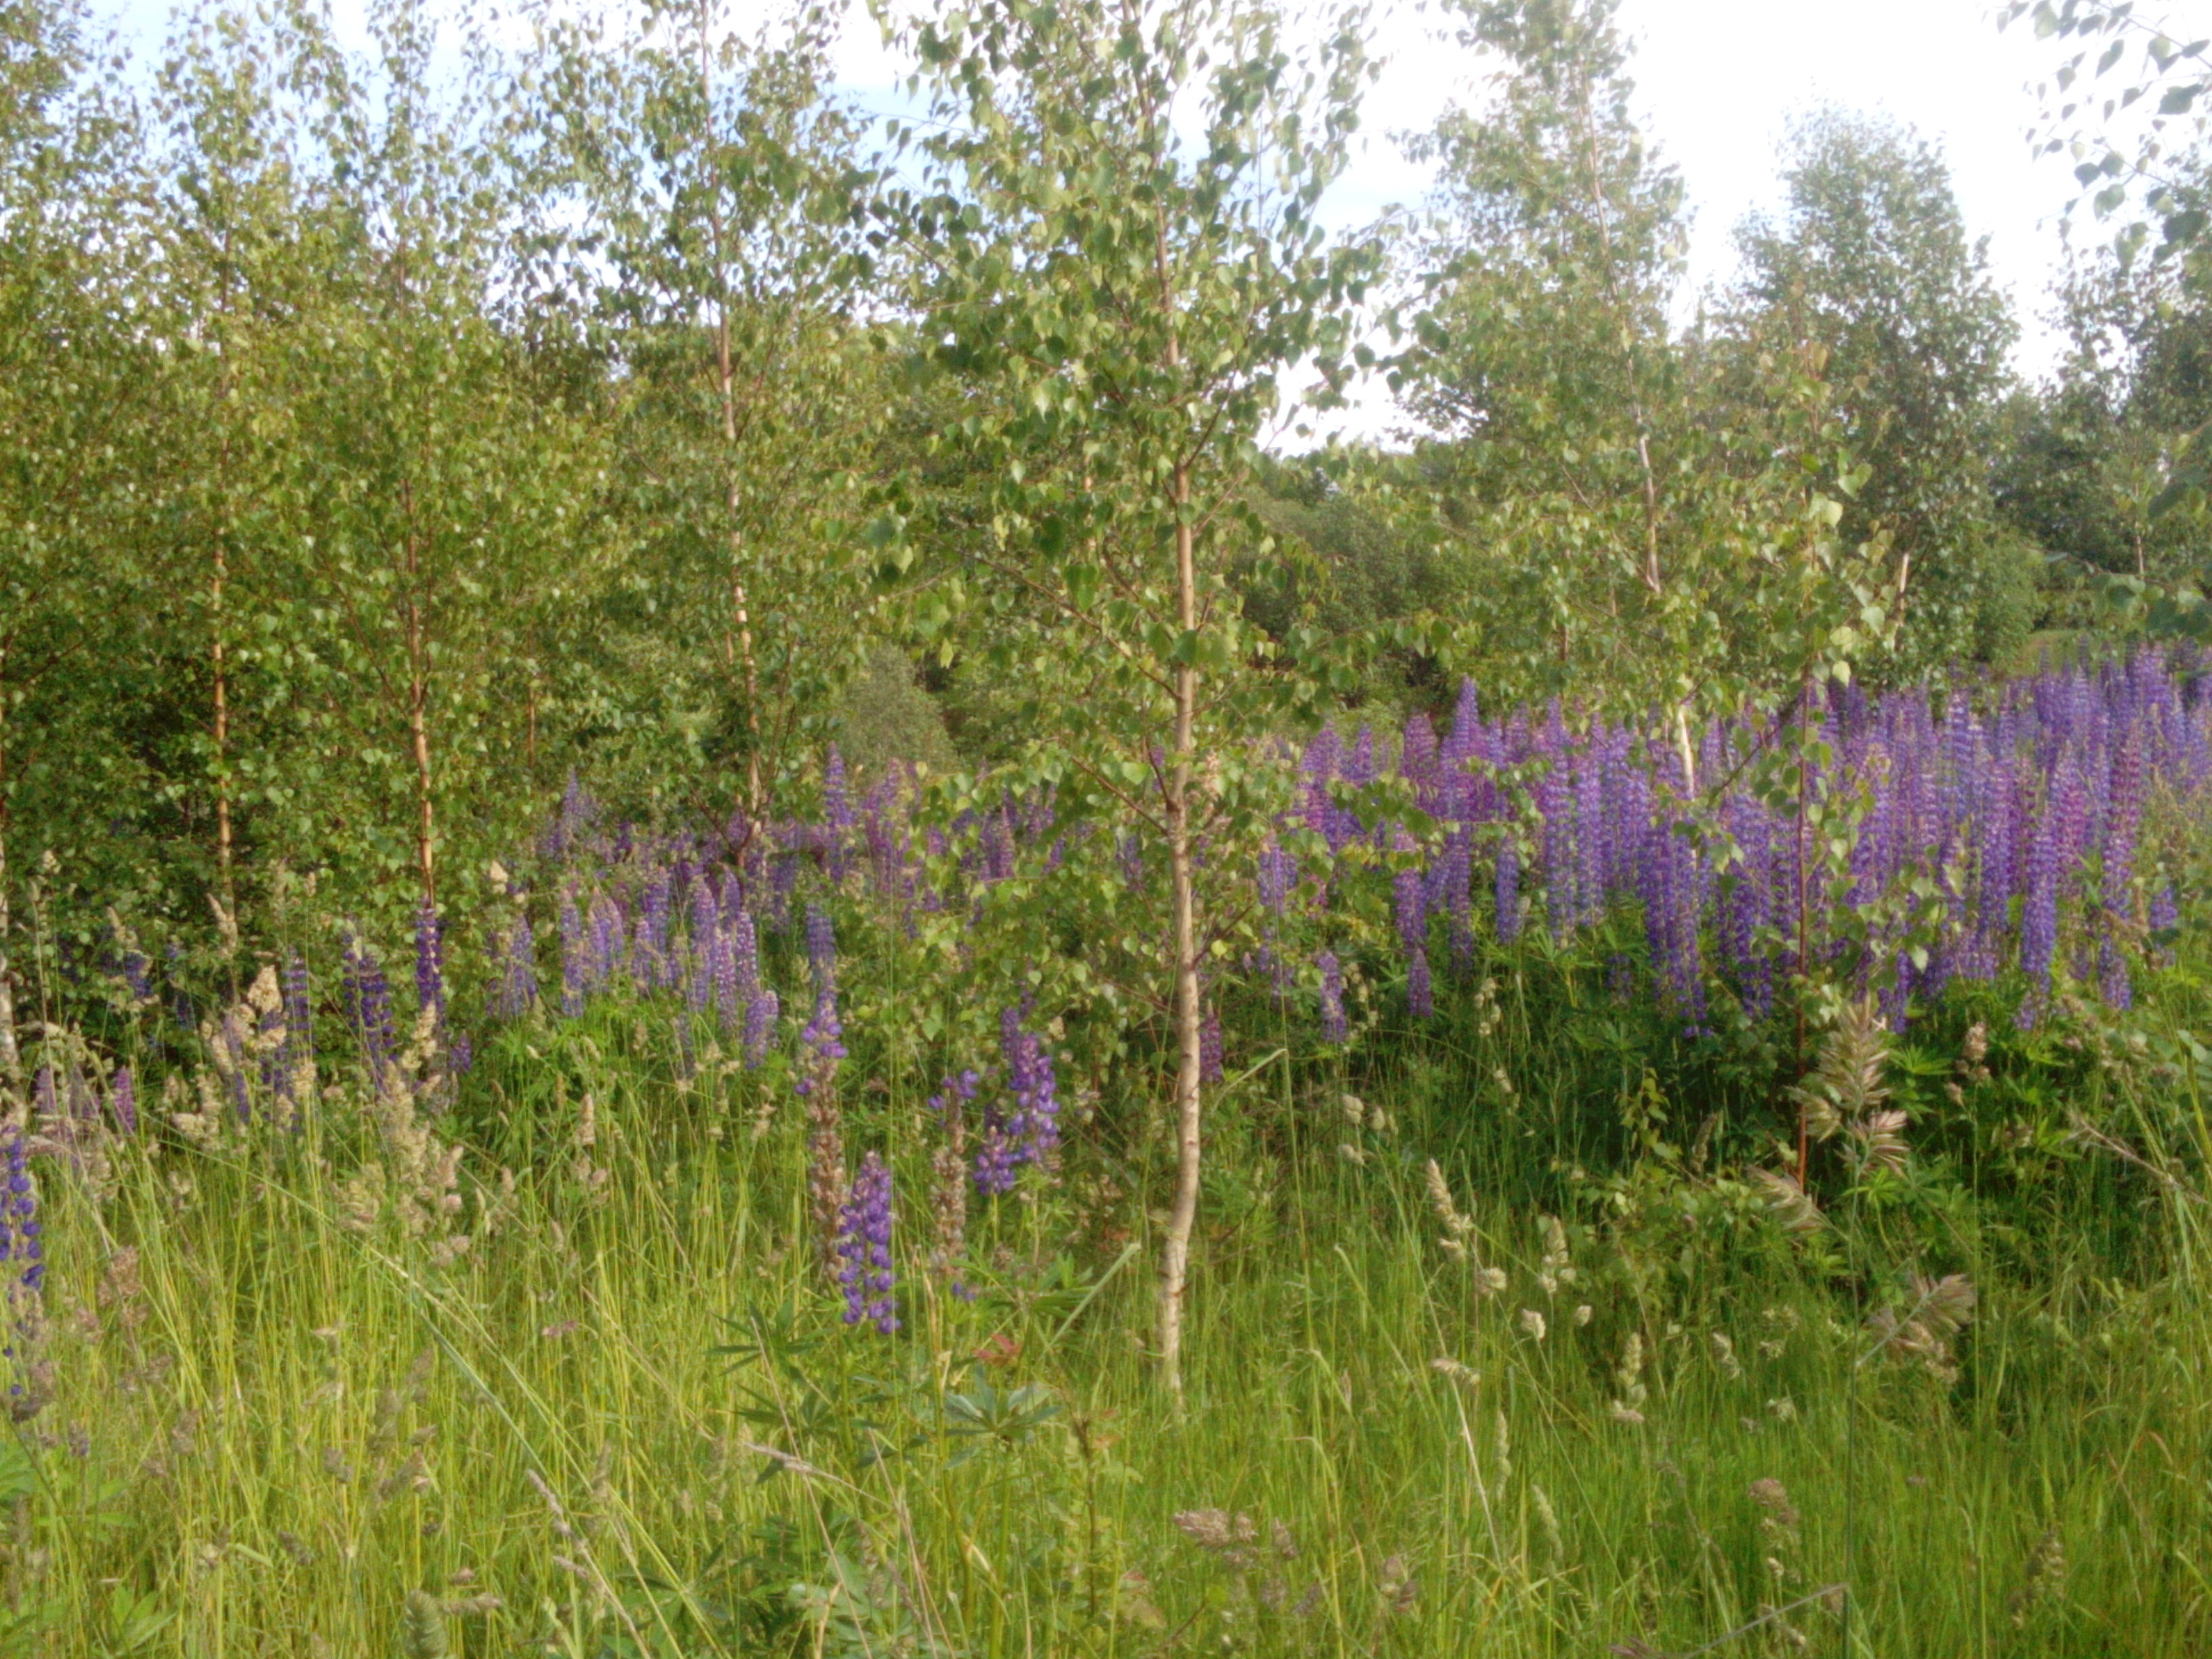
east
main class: Grassland
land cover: Grassland with sparse tree/shrub cover
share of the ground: > 75 %
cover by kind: herbaceous plants 85 %, shrubs 10 %, broadleaved forest trees 5 %
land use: Agriculture (excluding fallow land and kitchen gardens)
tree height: < 5 m
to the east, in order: Grassland with sparse tree/shrub cover; Broadleaved woodland; Tracks; Broadleaved woodland; Inland fresh running water; Broadleaved woodland; Spontaneously vegetated surfaces; Paved roads, cycling and walking lanes; Spontaneously vegetated surfaces
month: June
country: LV
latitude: 56.7330
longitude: 21.7981
